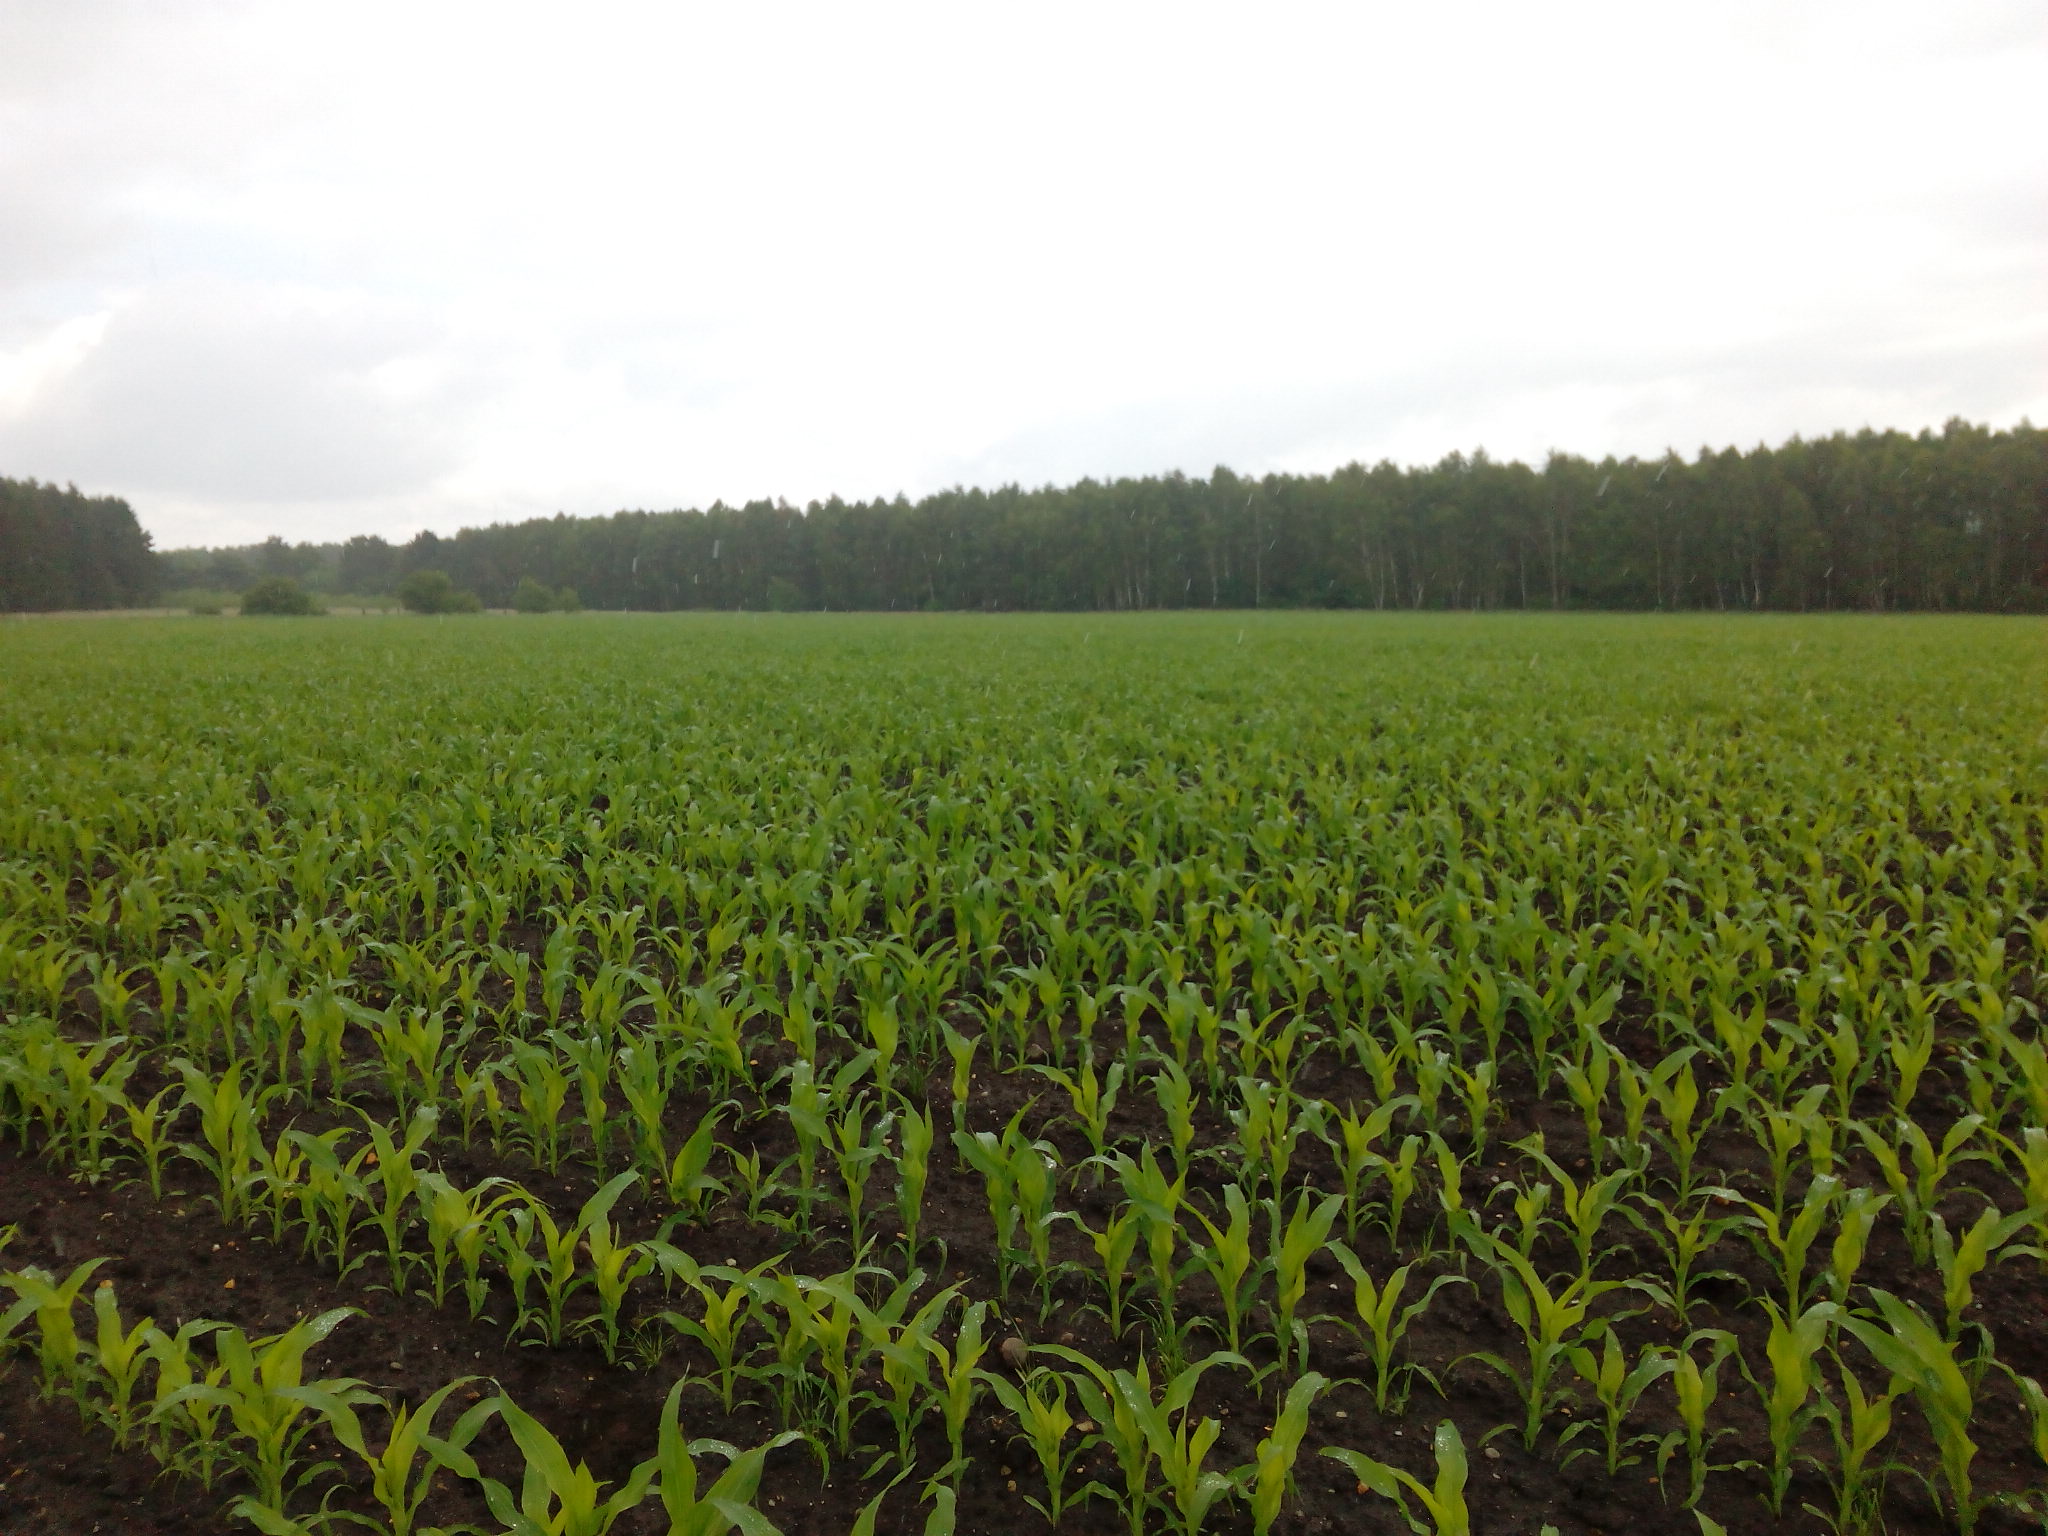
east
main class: Cropland
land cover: Maize
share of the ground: 50 - 75 %
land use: Agriculture (excluding fallow land and kitchen gardens)
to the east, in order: Maize; Grassland without tree/shrub cover; Ditches and canals; Grassland without tree/shrub cover; Ditches and canals; Broadleaved woodland
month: June
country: DE
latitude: 52.8987
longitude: 9.9257
